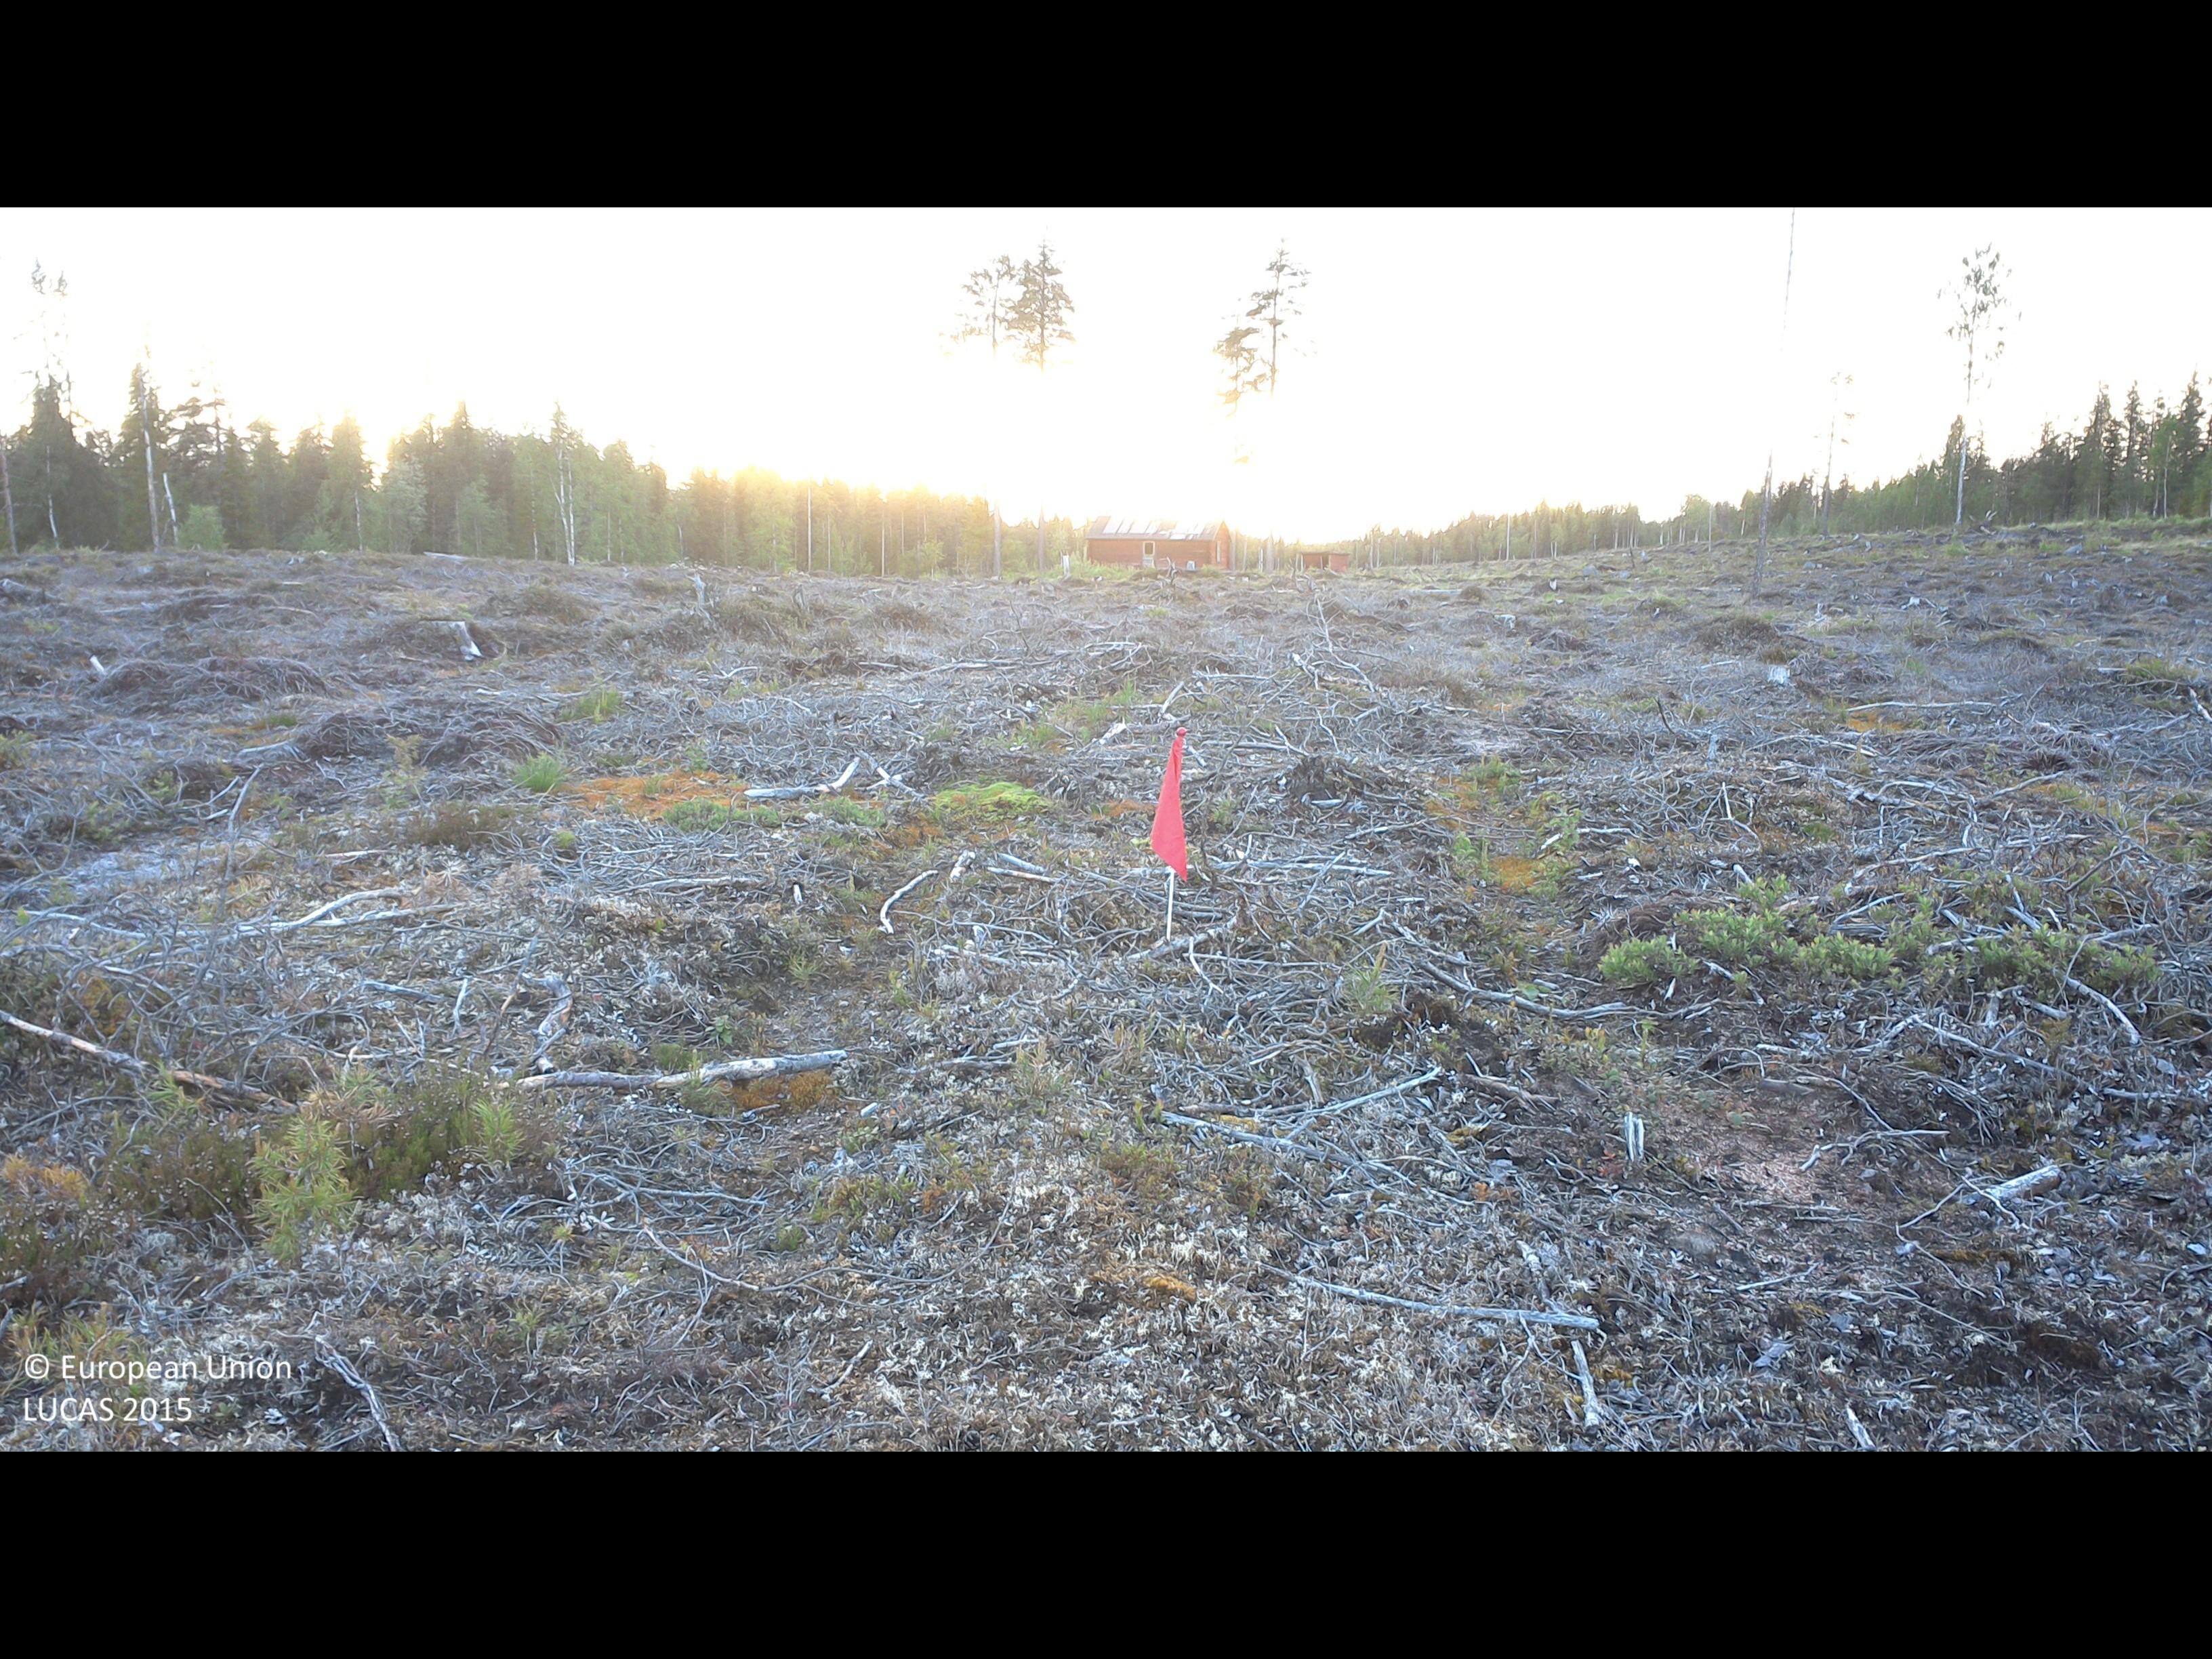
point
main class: Shrubland
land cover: Shrubland without tree cover
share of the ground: 10 - 25 %
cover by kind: unconsolidated bare surface 45 %, herbaceous plants 30 %, shrubs 15 %, lichens and mosses 10 %
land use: Forestry
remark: Clear cut
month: June
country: SE
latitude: 66.9474
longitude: 22.5299
